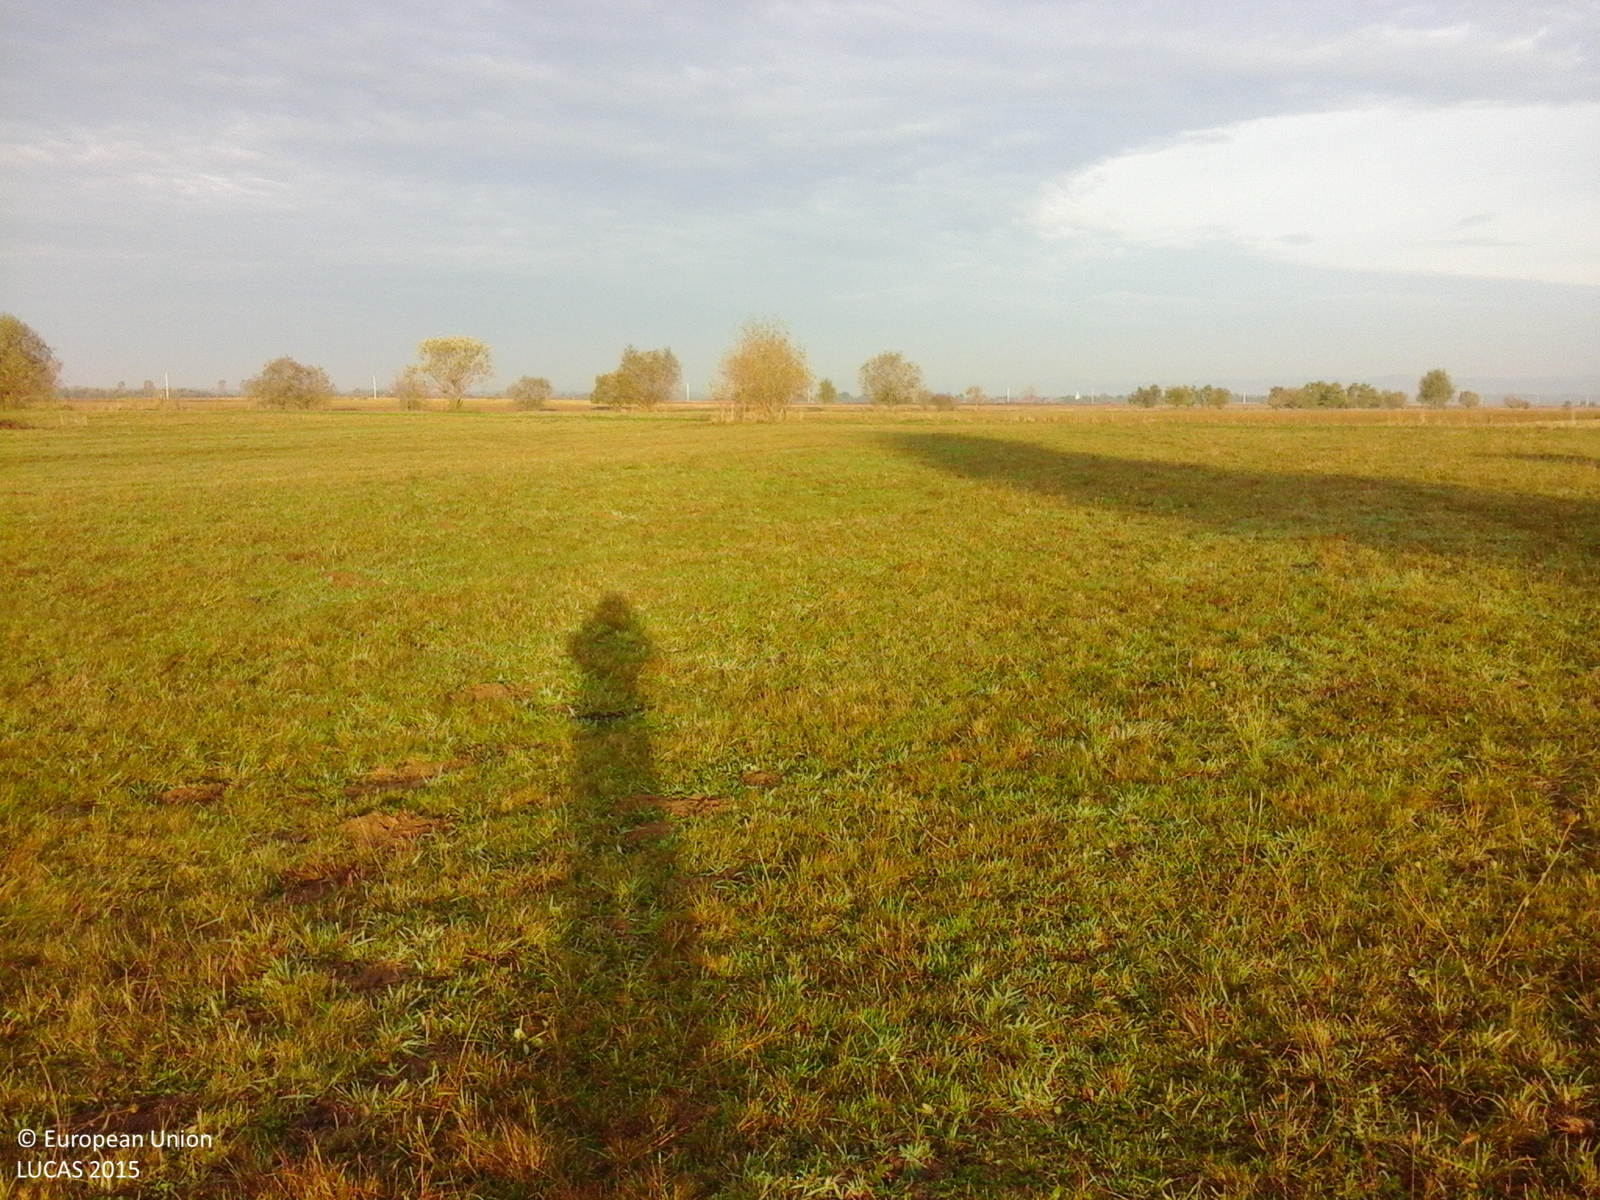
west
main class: Grassland
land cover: Grassland without tree/shrub cover
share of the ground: > 75 %
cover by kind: herbaceous plants 100 %
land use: Agriculture (excluding fallow land and kitchen gardens)
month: October
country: RO
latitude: 45.7380
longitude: 25.0393
